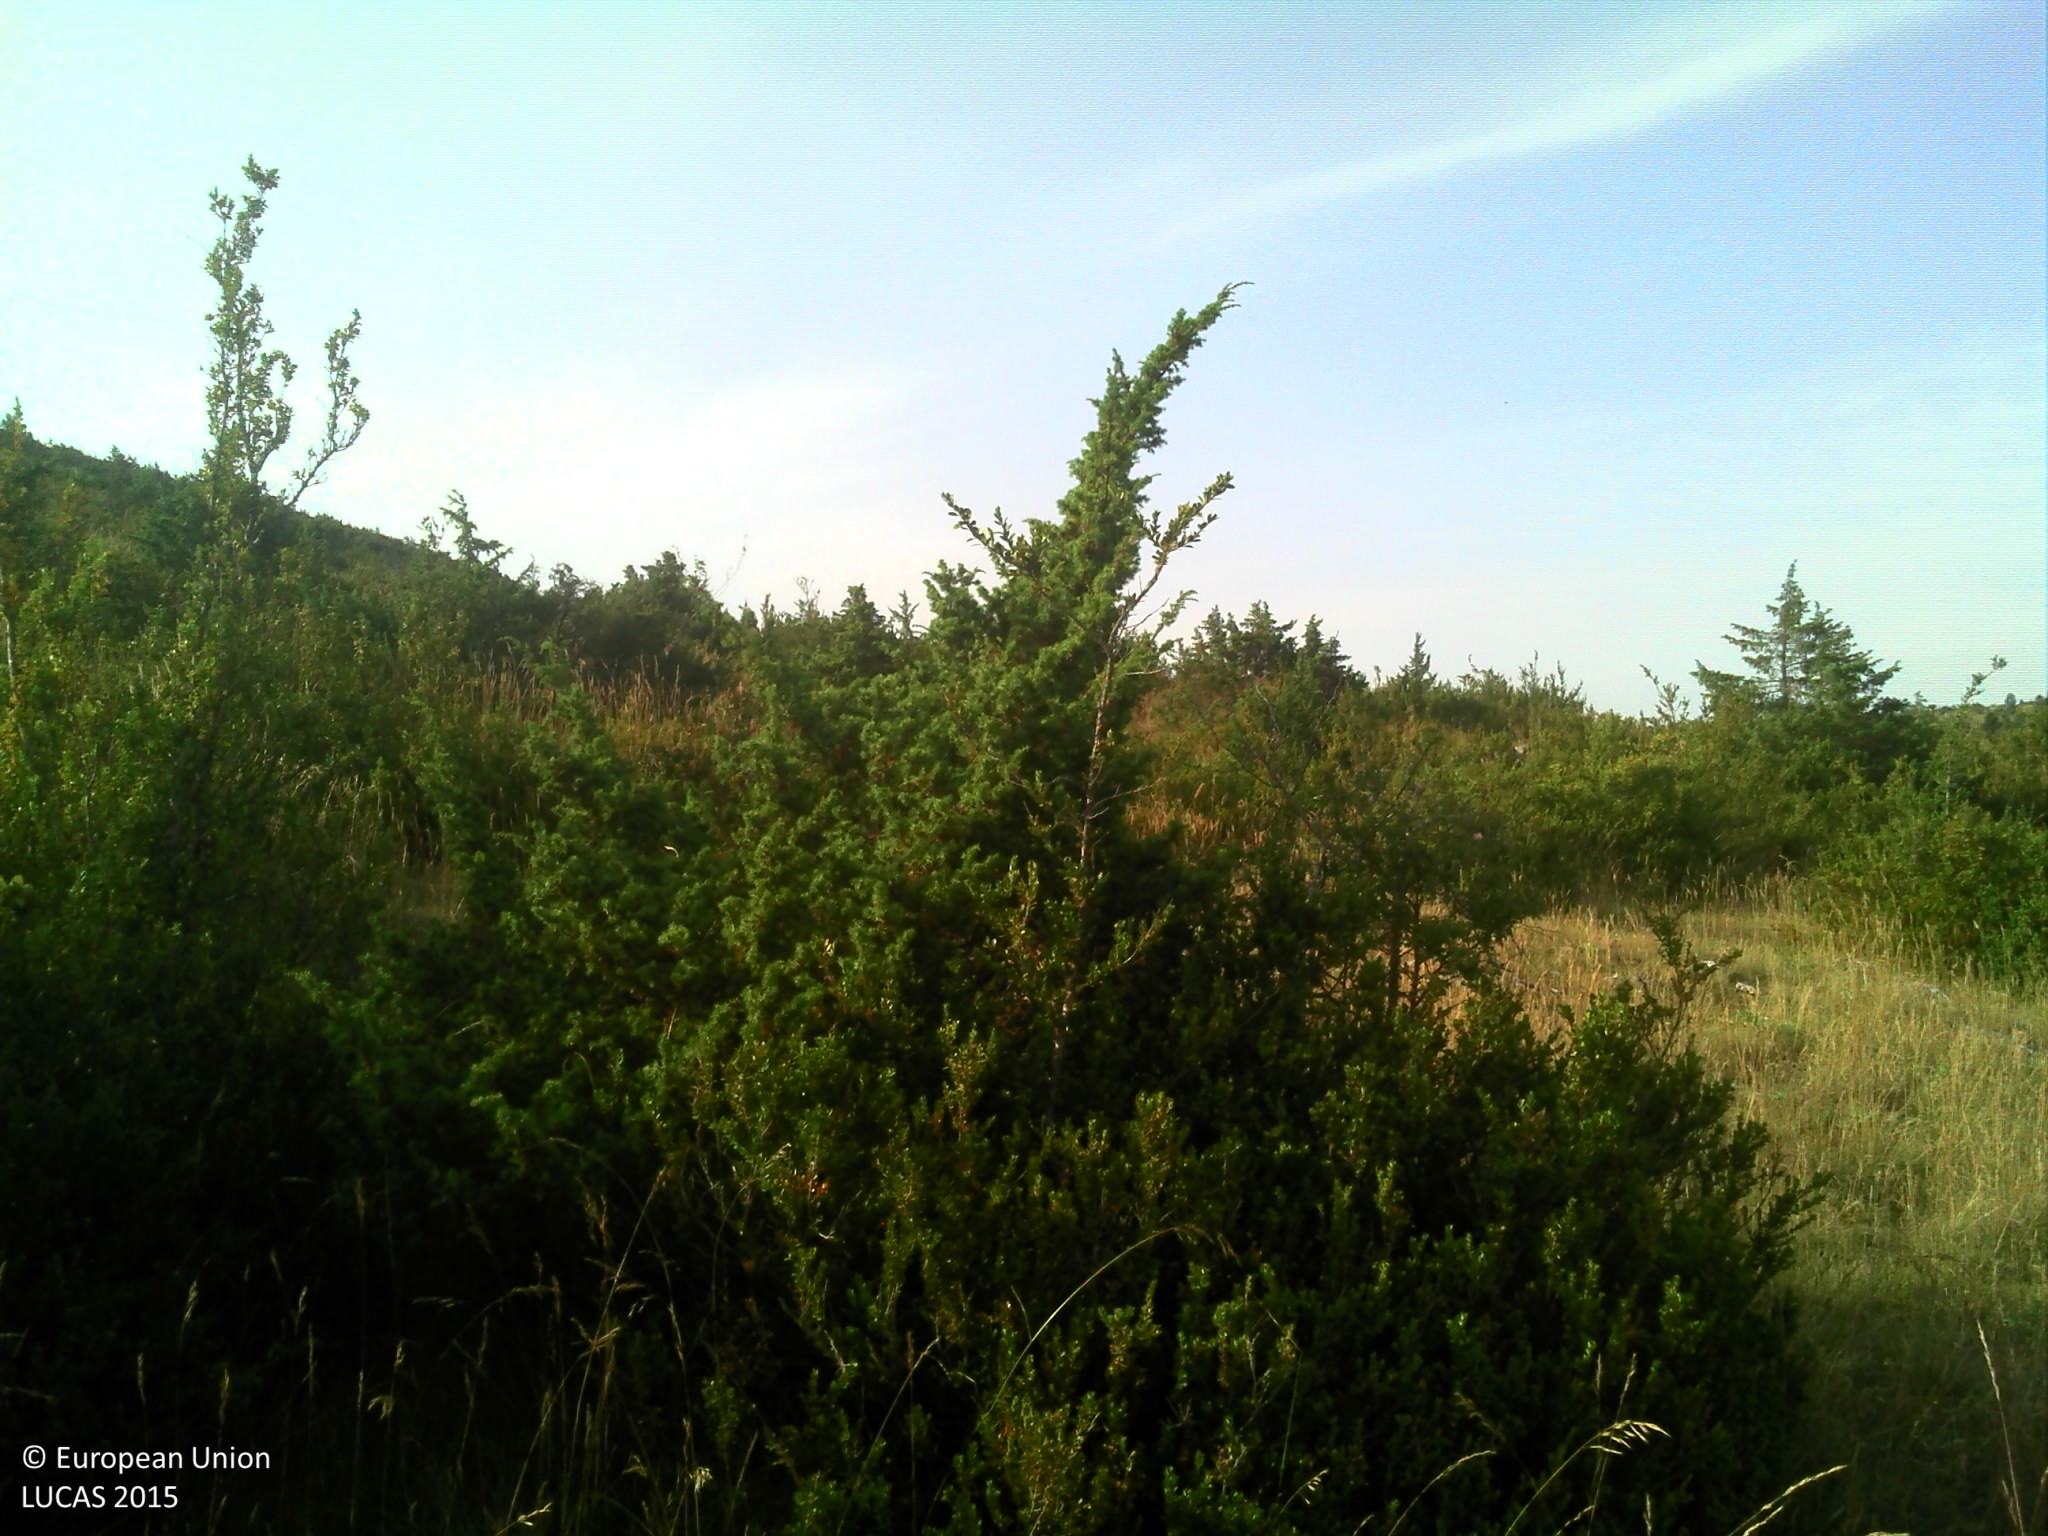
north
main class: Shrubland
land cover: Shrubland with sparse tree cover
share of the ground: > 75 %
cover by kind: shrubs 45 %, herbaceous plants 45 %, coniferous forest trees 5 %
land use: Semi-natural and natural areas not in use
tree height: < 5 m
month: July
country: FR
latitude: 44.3306
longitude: 3.5475
